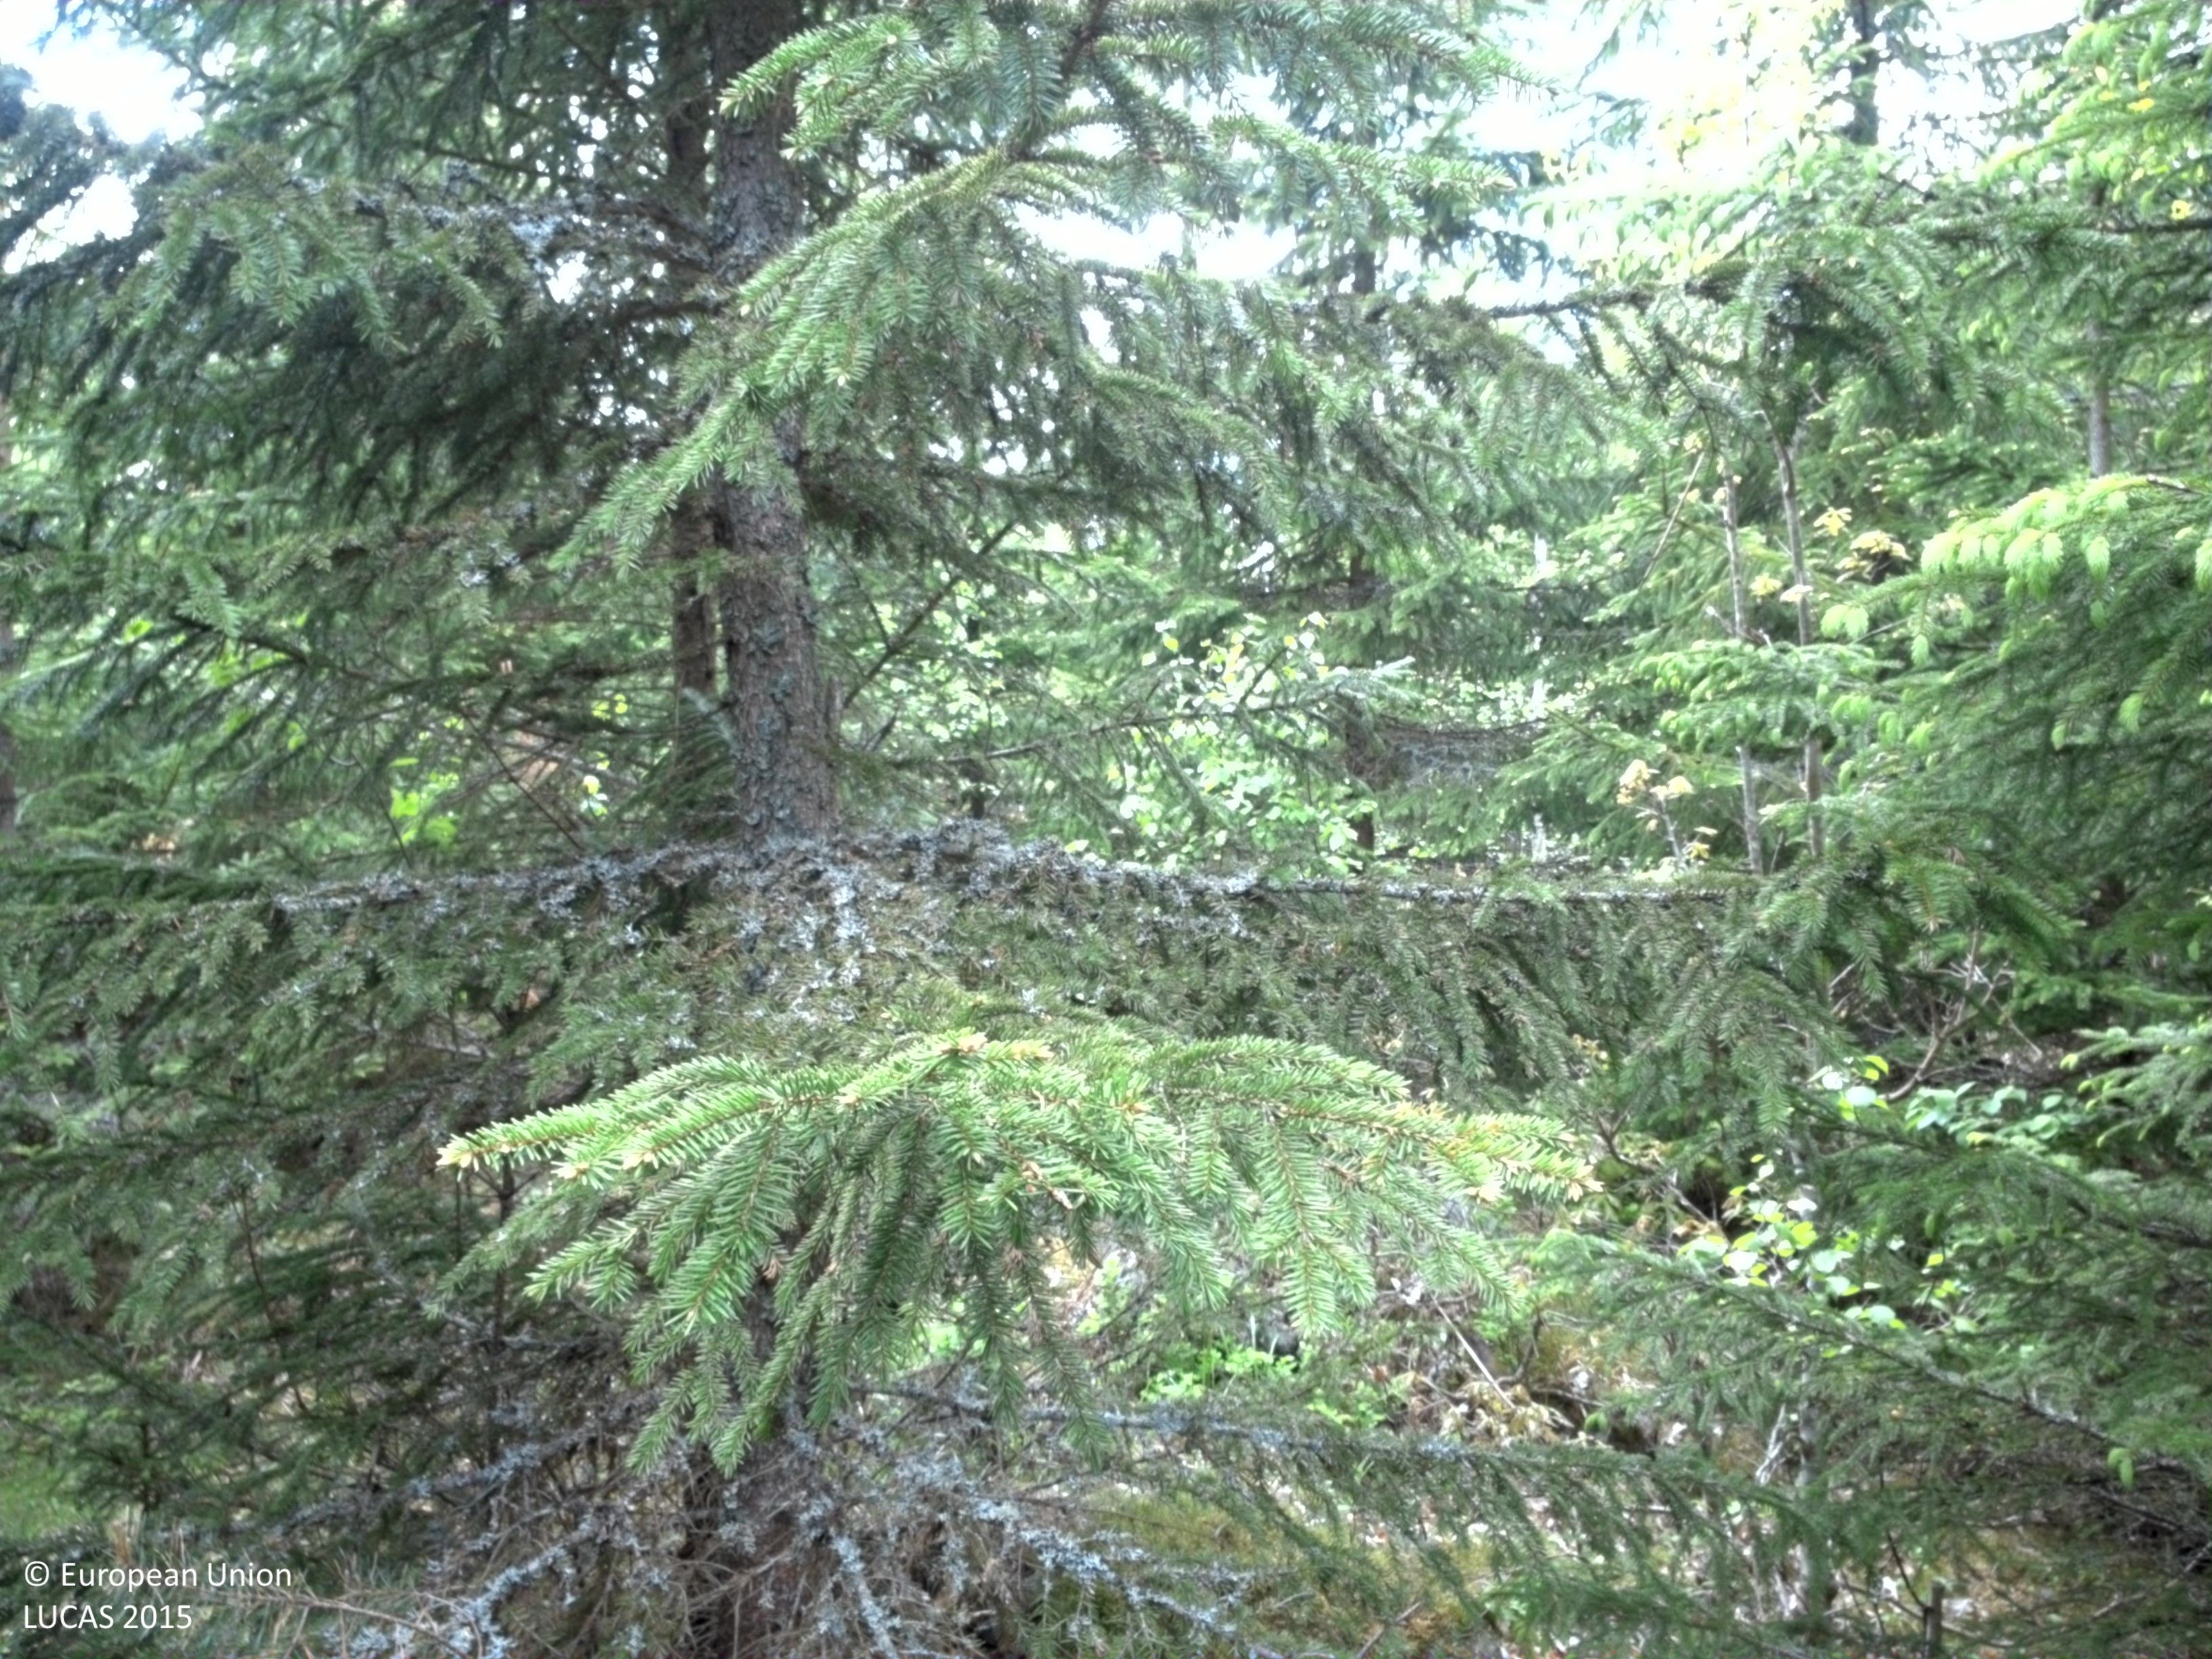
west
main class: Woodland
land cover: Spruce dominated coniferous woodland
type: boreal forest
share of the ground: 50 - 75 %
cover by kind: coniferous forest trees 60 %, broadleaved forest trees 10 %, shrubs 10 %, herbaceous plants 10 %, lichens and mosses 10 %
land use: Forestry
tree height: > 5 m
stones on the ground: > 50 %
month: May
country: SE
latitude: 57.2565
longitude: 15.9827
